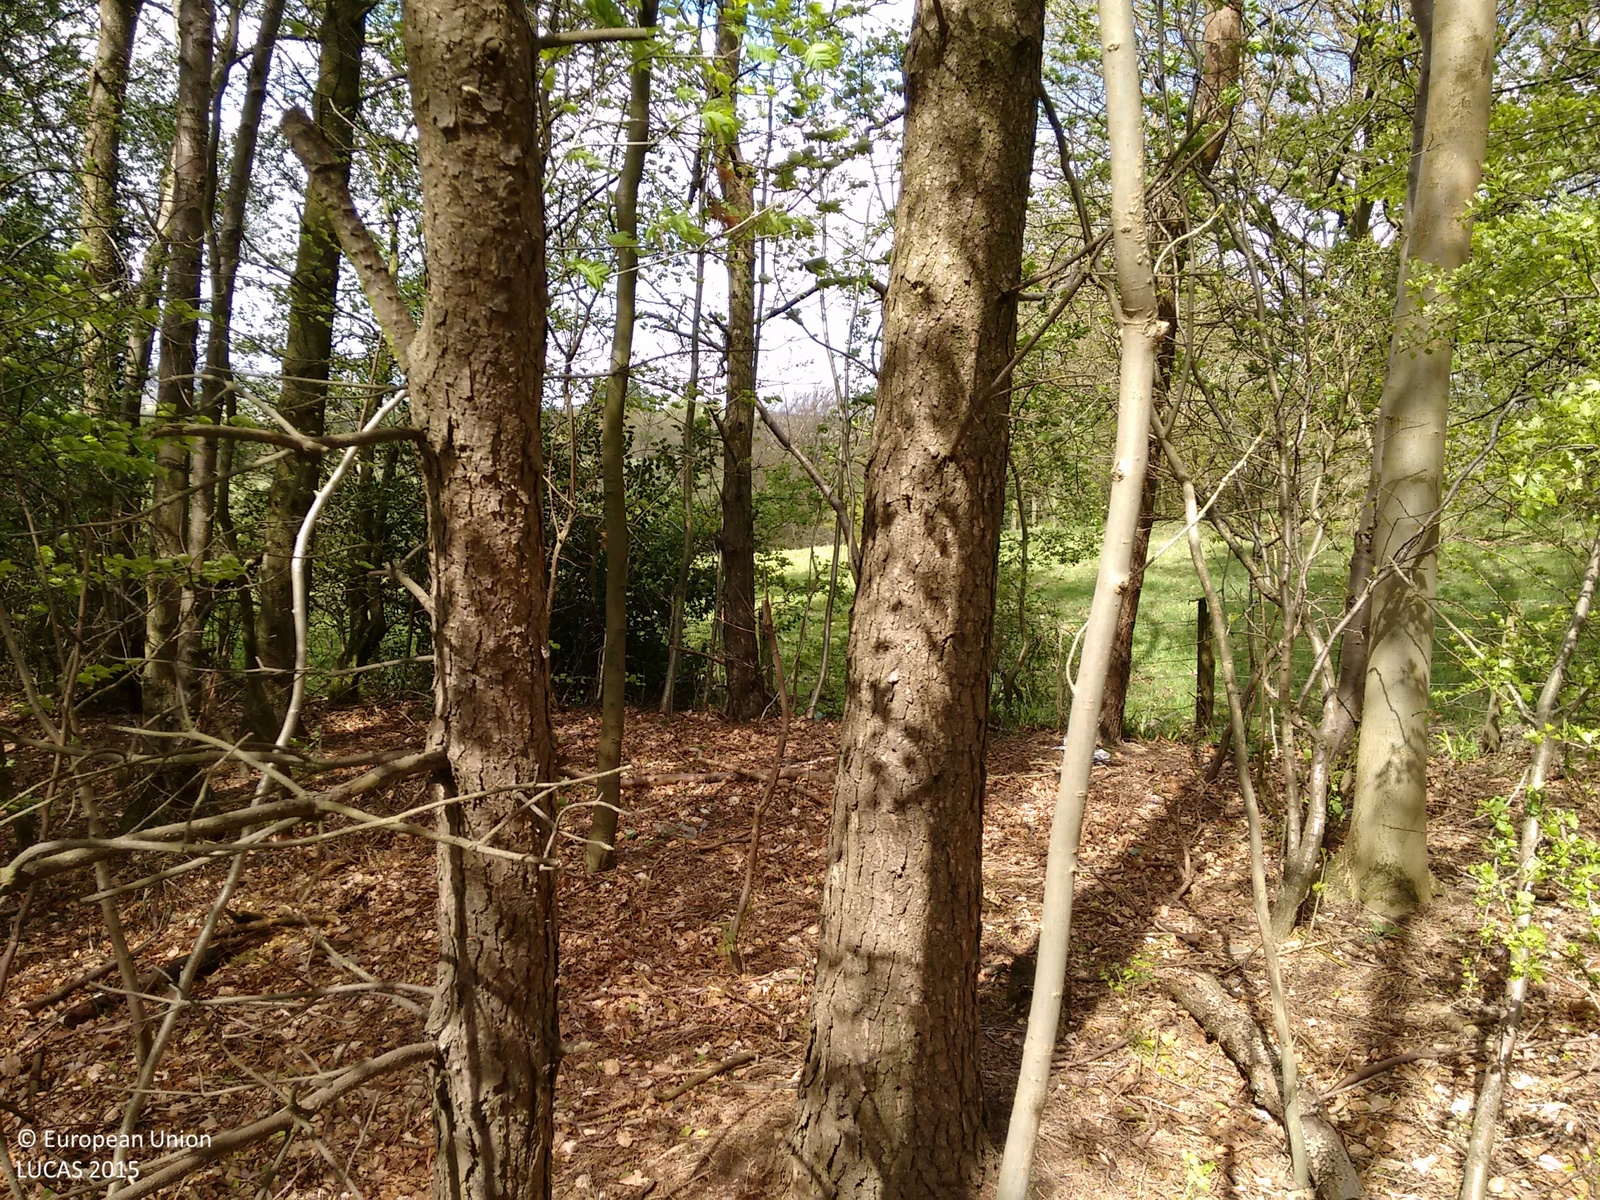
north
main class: Woodland
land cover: Broadleaved woodland
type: exotic forest
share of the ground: > 75 %
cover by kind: broadleaved forest trees 90 %, coniferous forest trees 10 %
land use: Amenities, museums, leisure
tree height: > 5 m
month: May
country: GB
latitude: 55.9695
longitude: -3.9454
